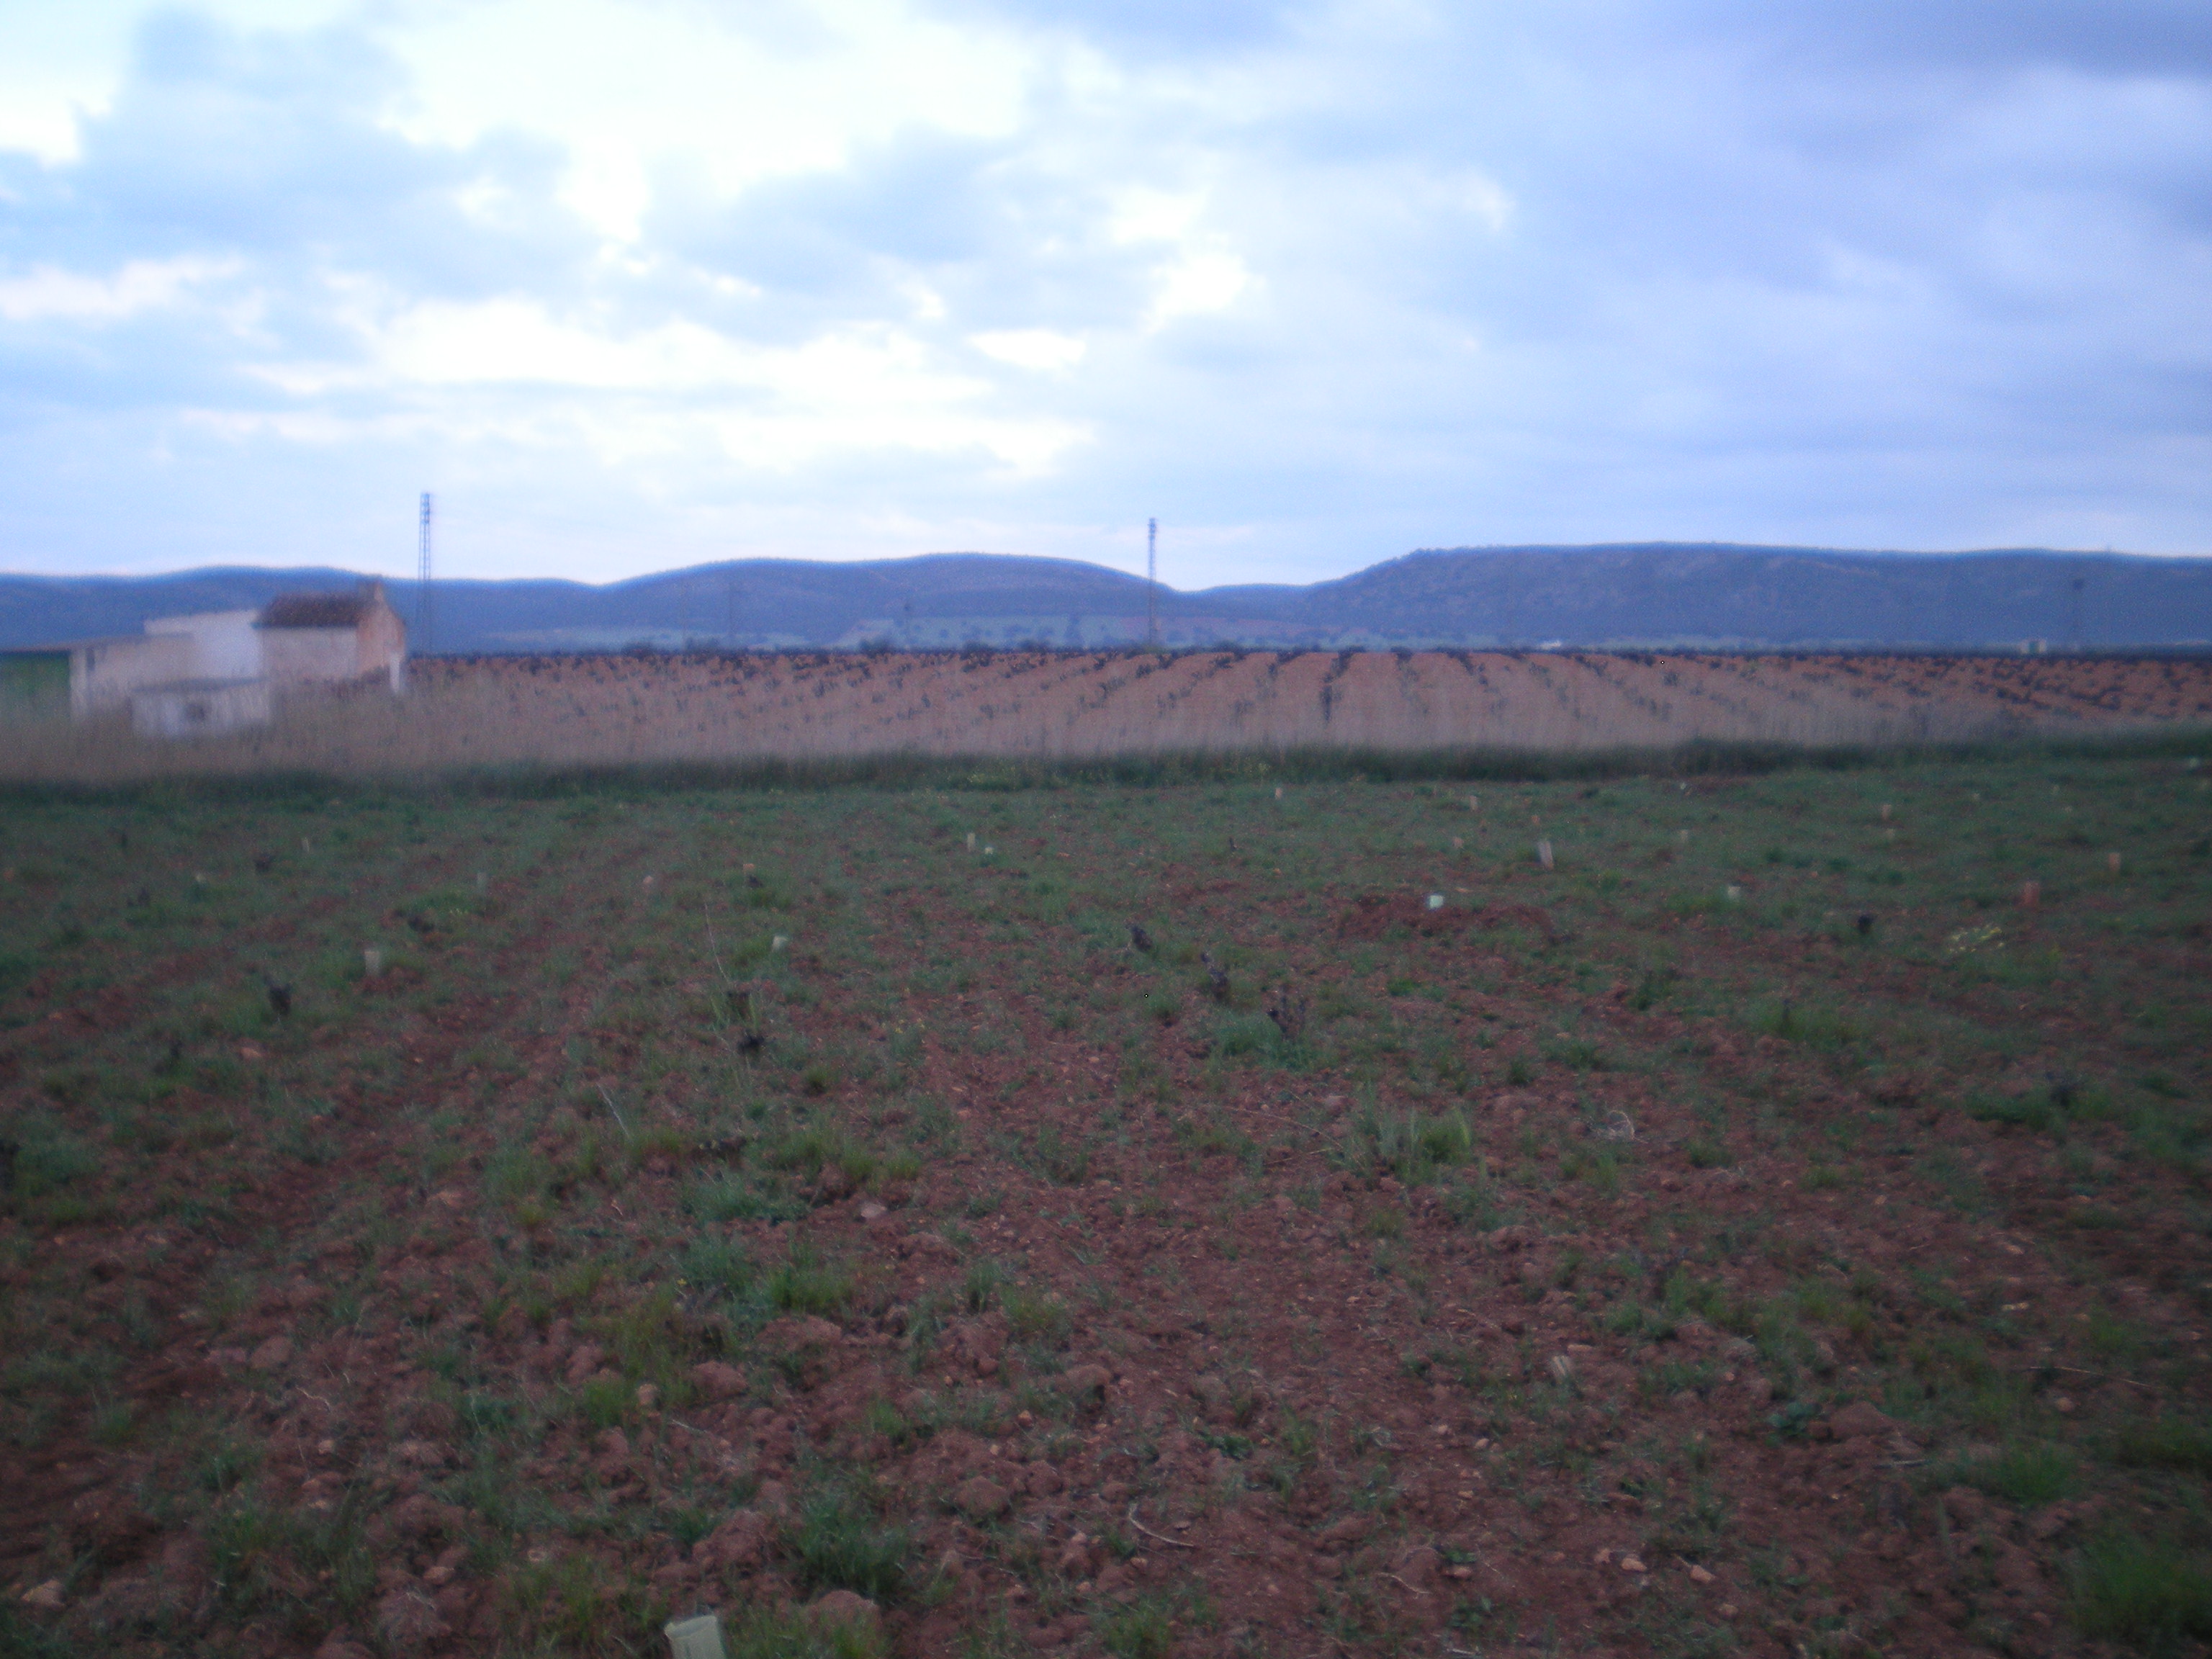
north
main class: Cropland
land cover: Vineyards
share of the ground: < 10 %
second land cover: Spontaneously vegetated surfaces
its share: 25 - 50 %
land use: Agriculture (excluding fallow land and kitchen gardens)
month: April
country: ES
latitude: 38.7809
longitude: -3.4921
